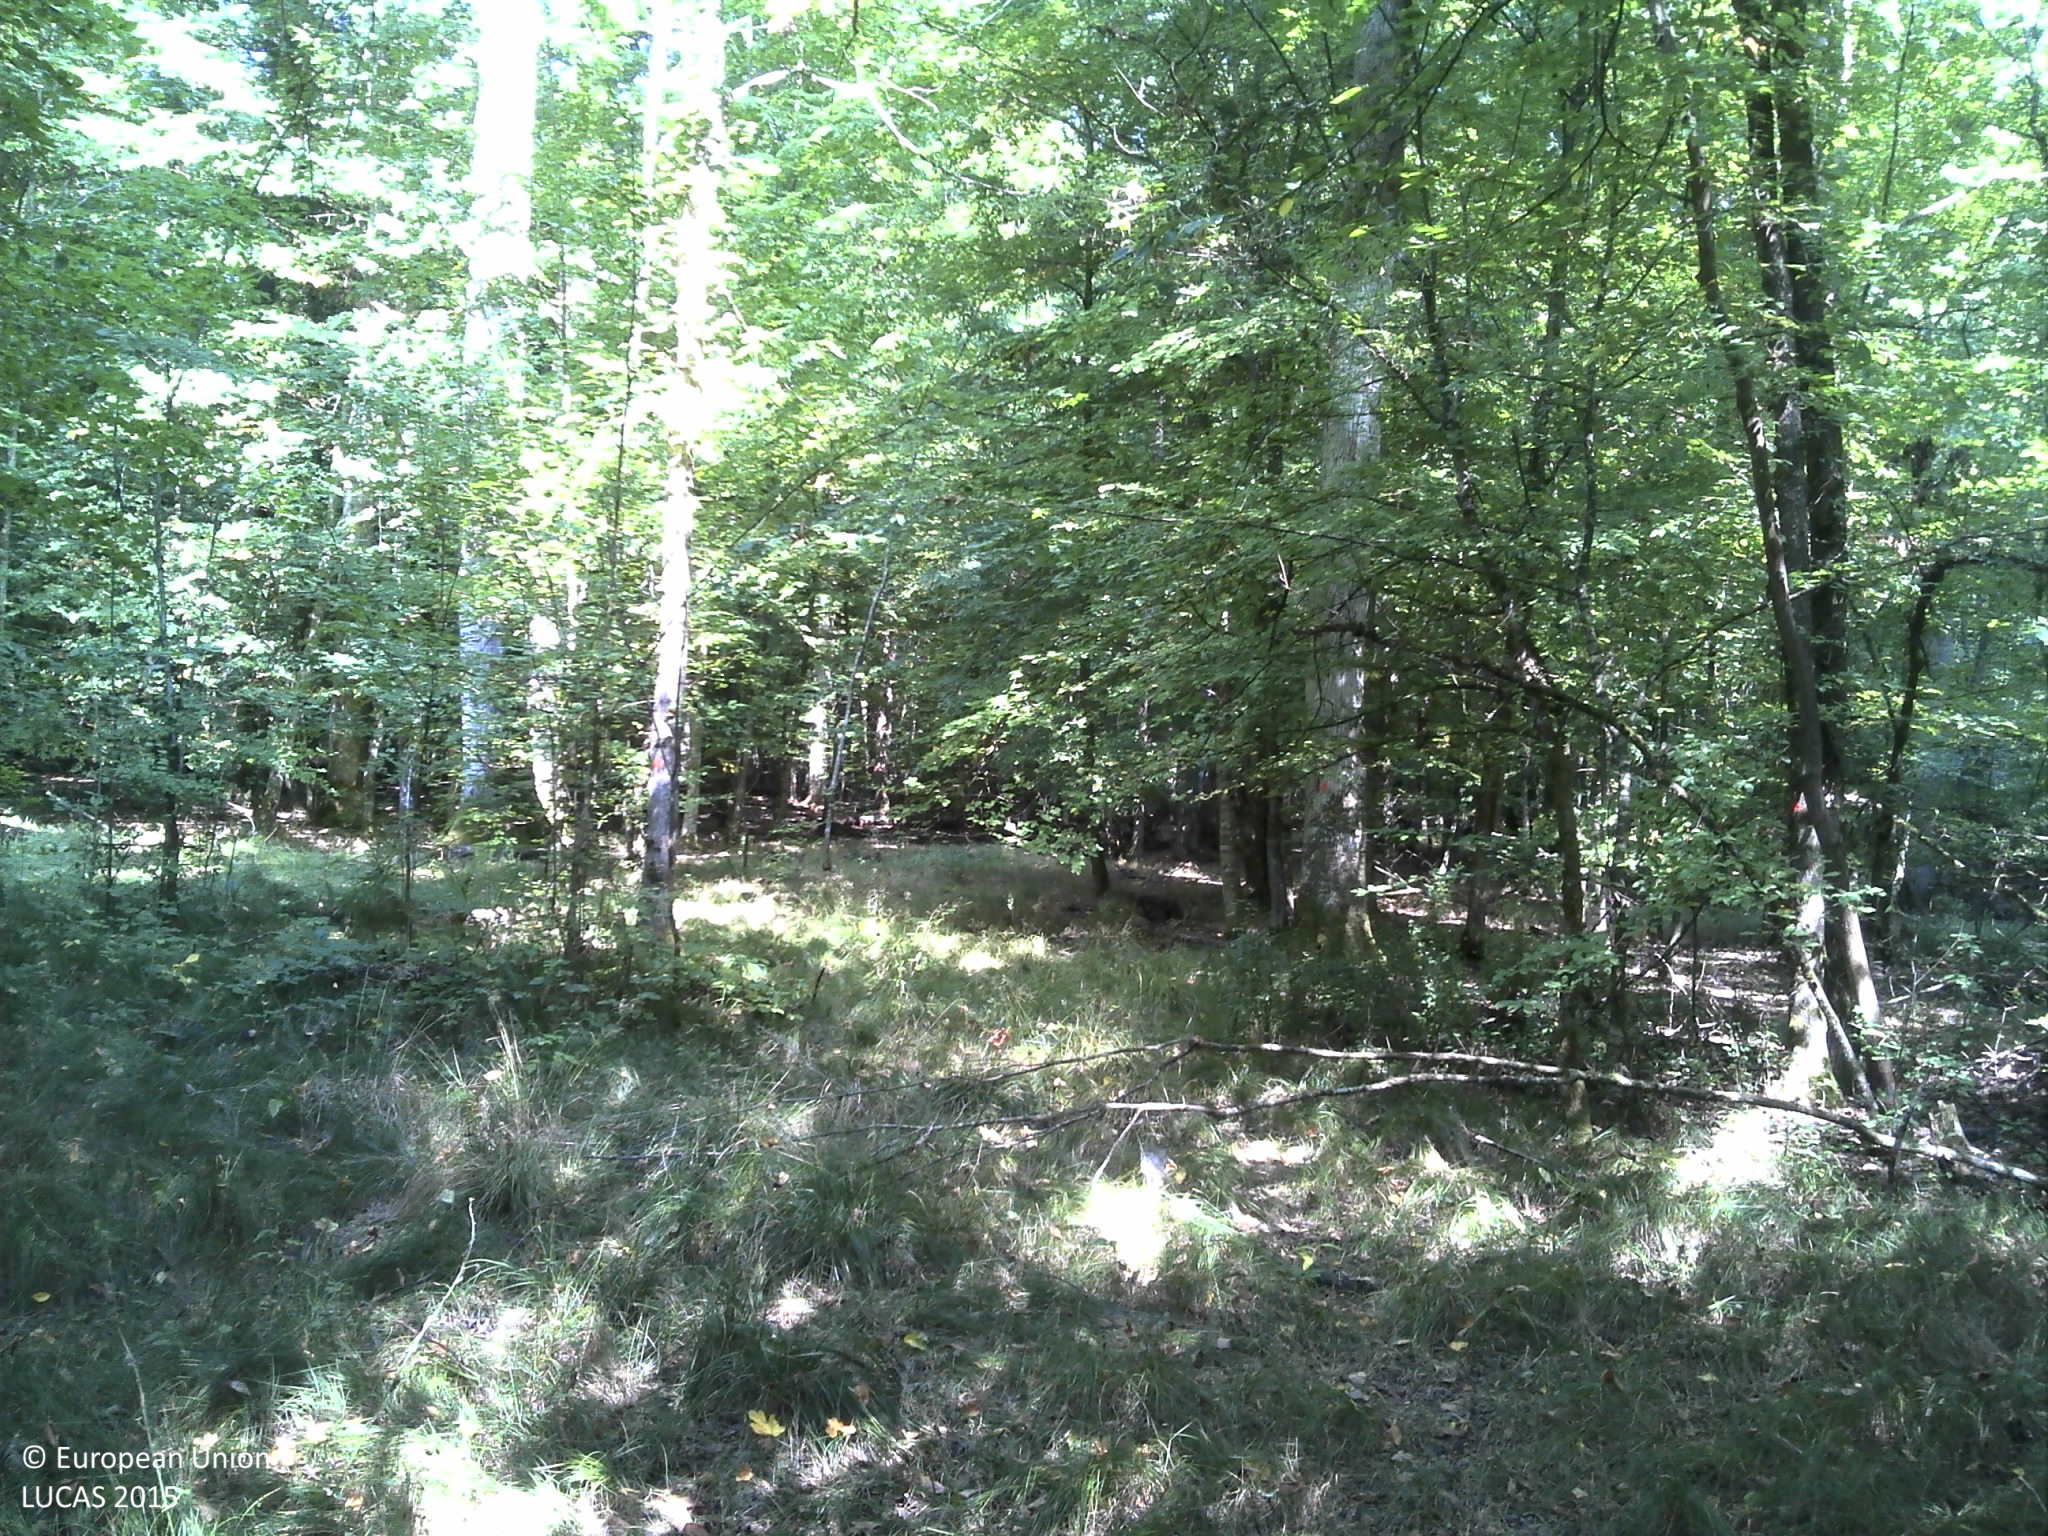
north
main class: Woodland
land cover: Broadleaved woodland
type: mesophytic deciduous forest
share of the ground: > 75 %
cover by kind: broadleaved forest trees 100 %
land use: Forestry
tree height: > 5 m
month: September
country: HR
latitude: 45.6784
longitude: 16.5850
